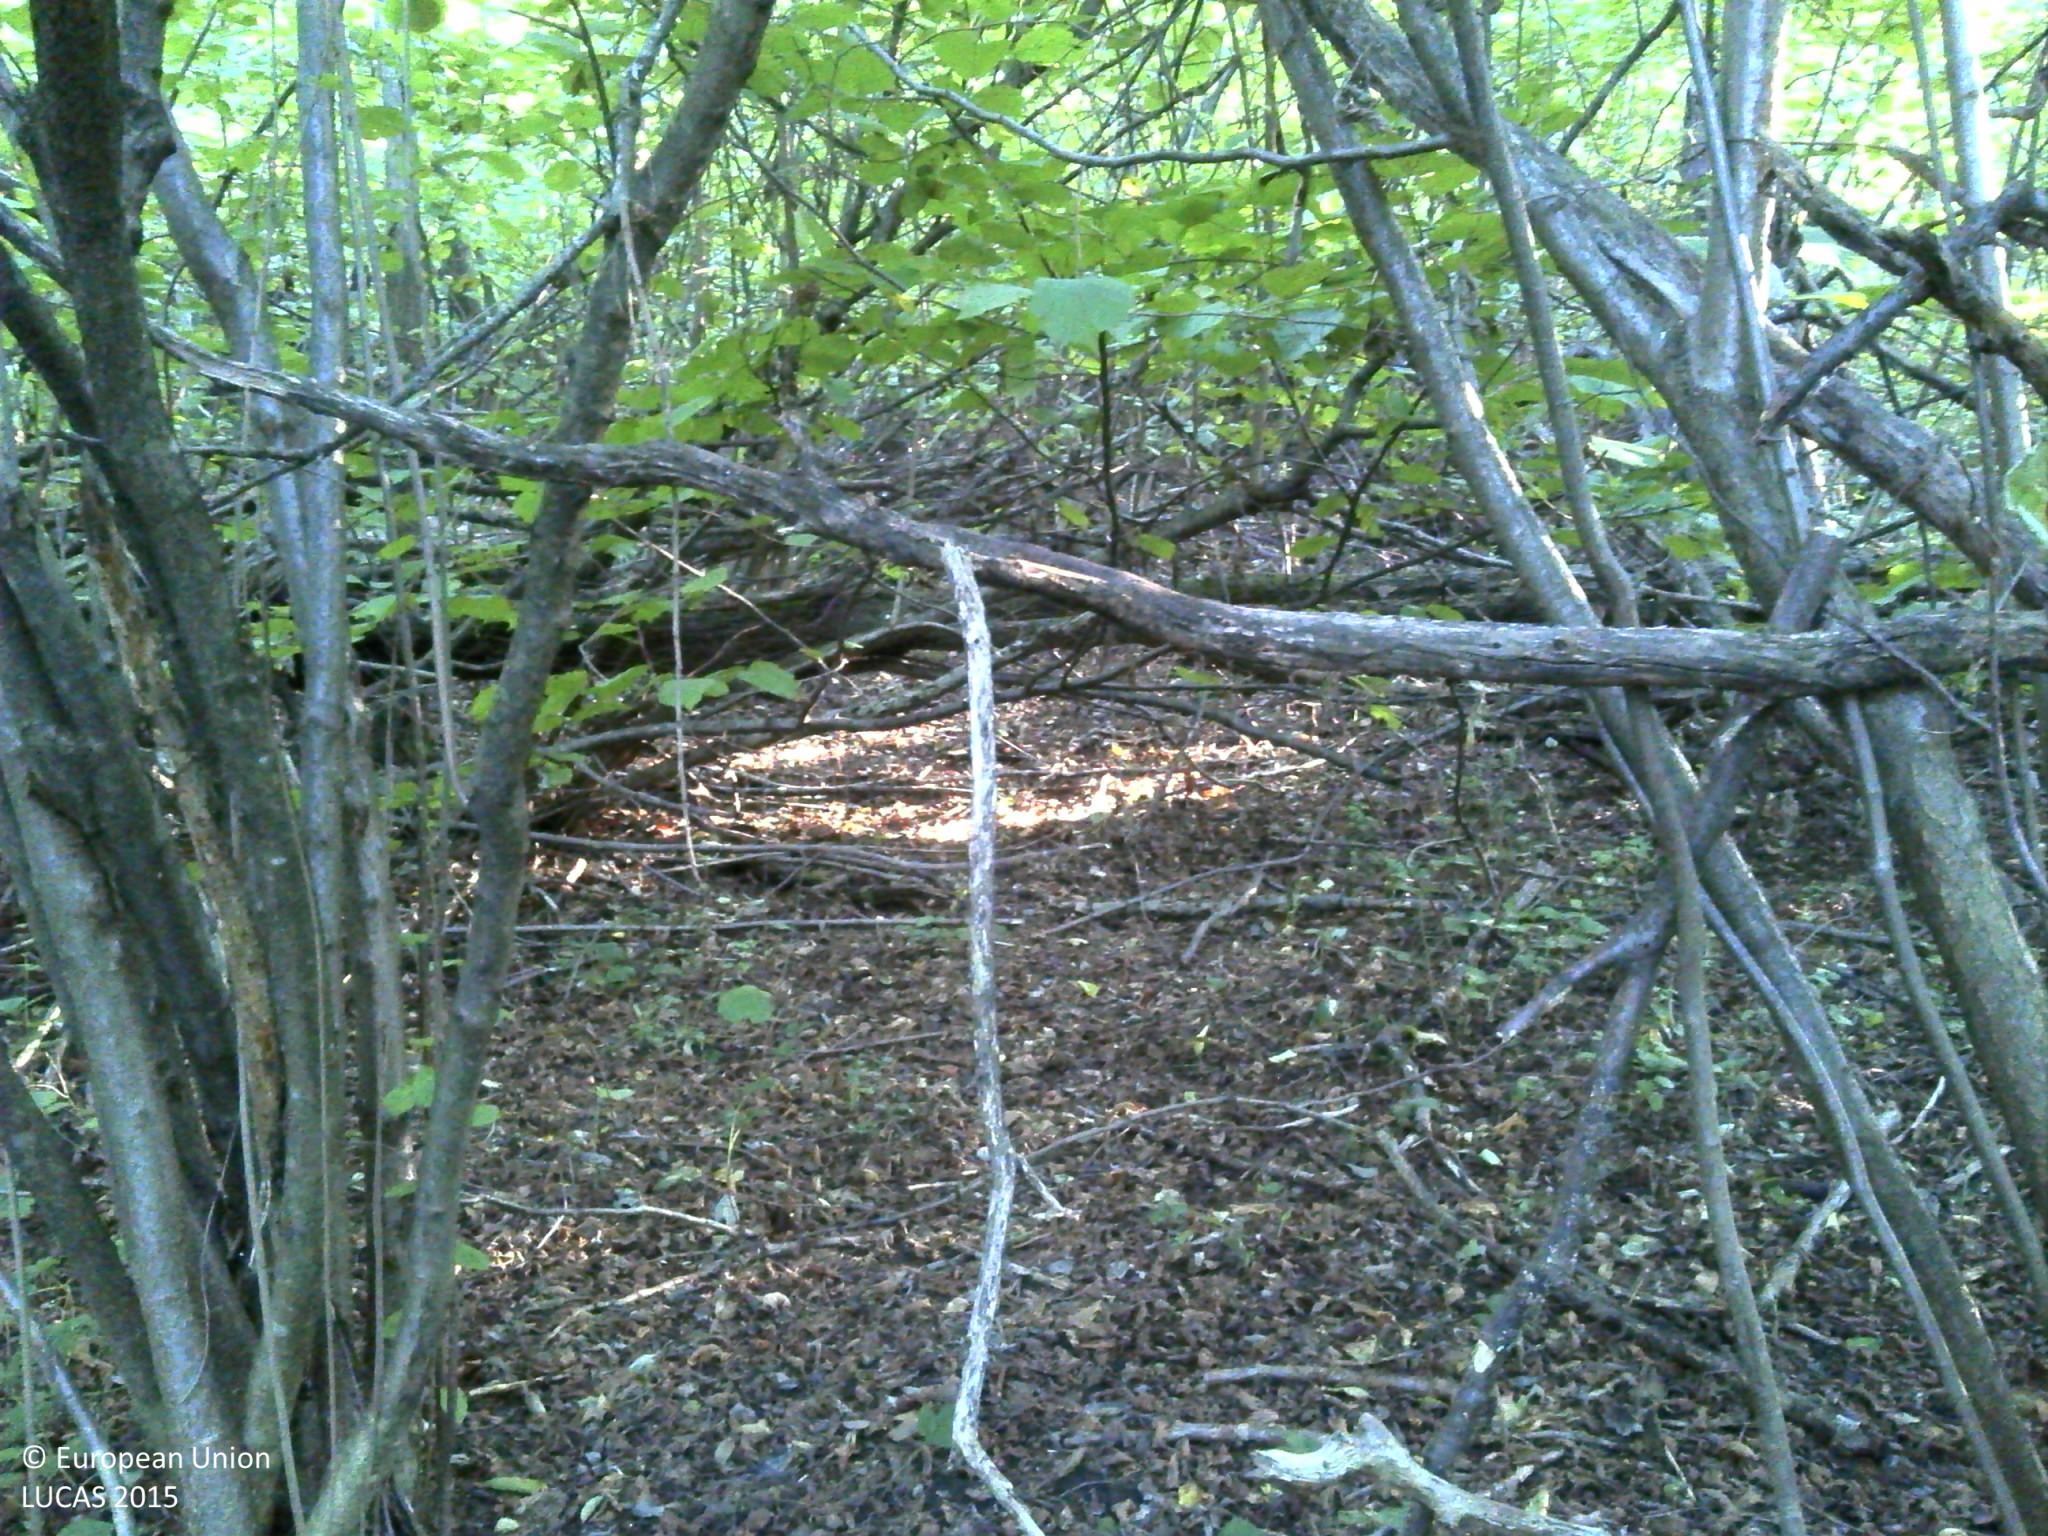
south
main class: Woodland
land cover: Broadleaved woodland
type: acidophilous oak and oak-birch forest
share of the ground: > 75 %
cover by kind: broadleaved forest trees 100 %
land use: Forestry
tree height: > 5 m
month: August
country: HR
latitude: 45.3140
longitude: 16.3368
